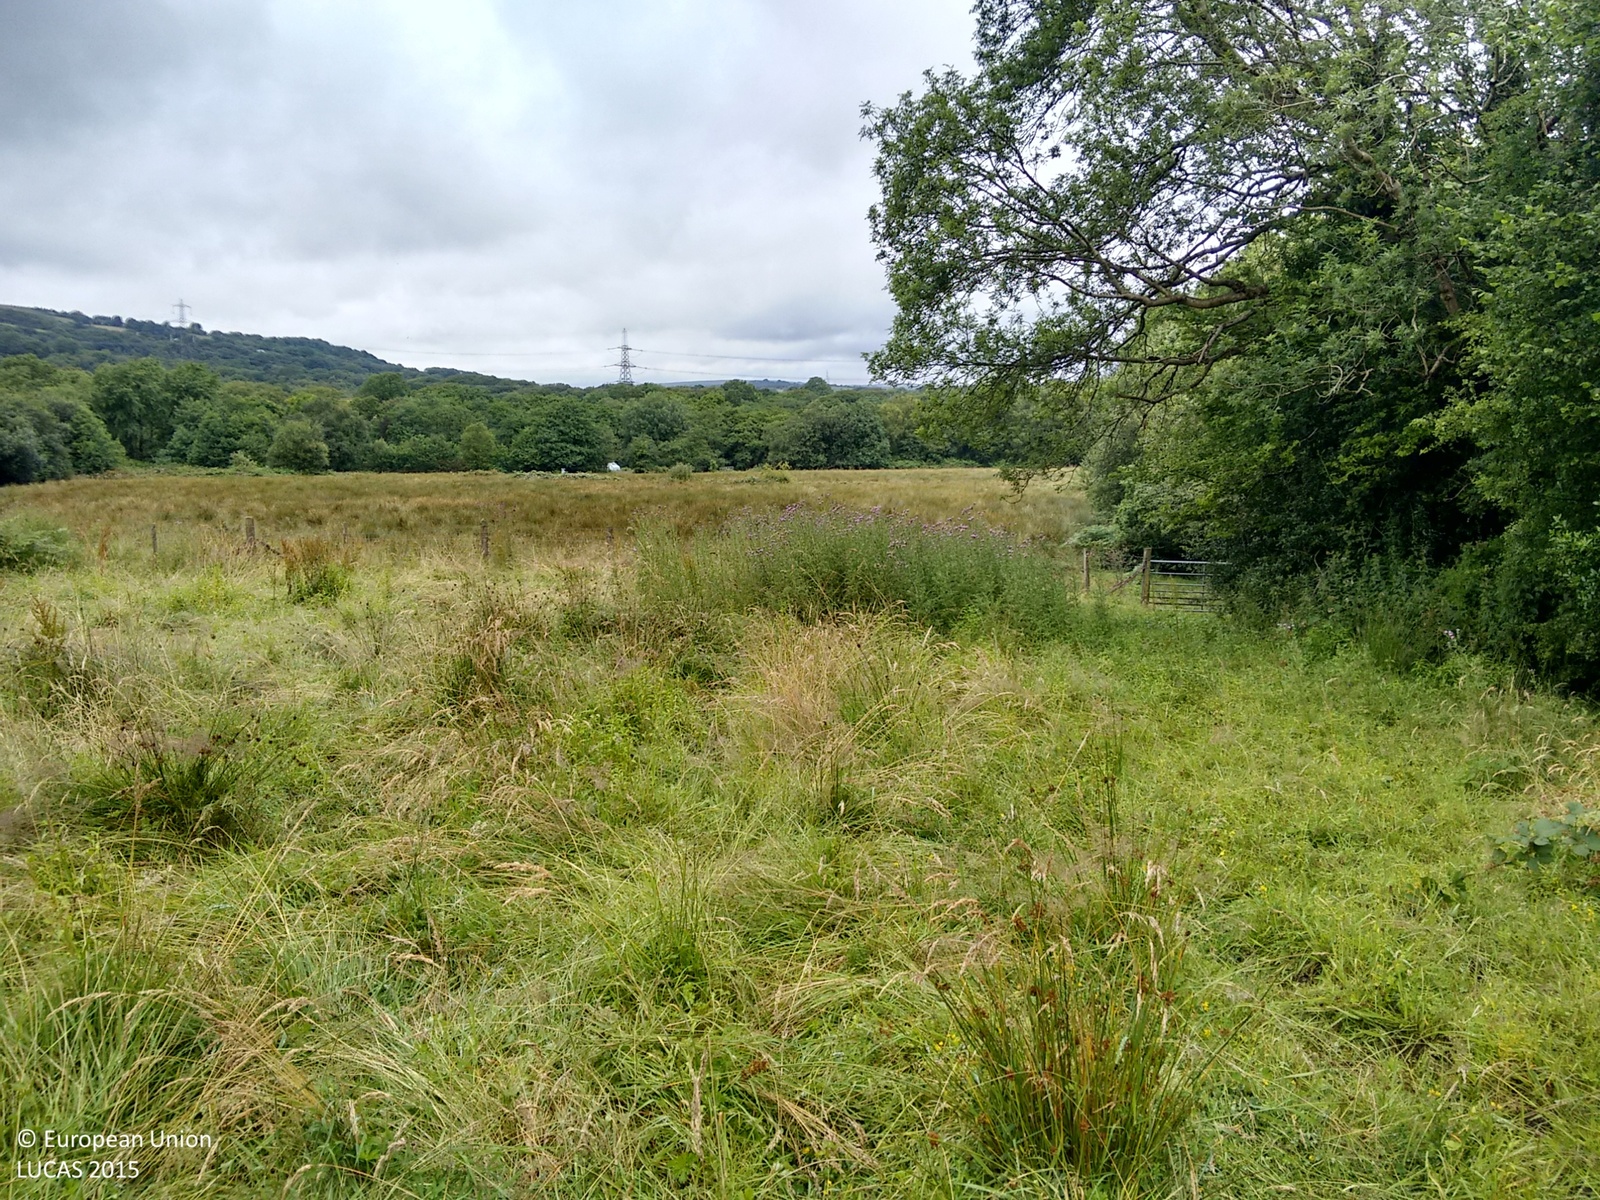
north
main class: Grassland
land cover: Grassland without tree/shrub cover
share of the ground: > 75 %
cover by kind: herbaceous plants 100 %
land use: Agriculture (excluding fallow land and kitchen gardens)
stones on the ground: < 10 %
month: July
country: GB
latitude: 51.6917
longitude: -3.8195
